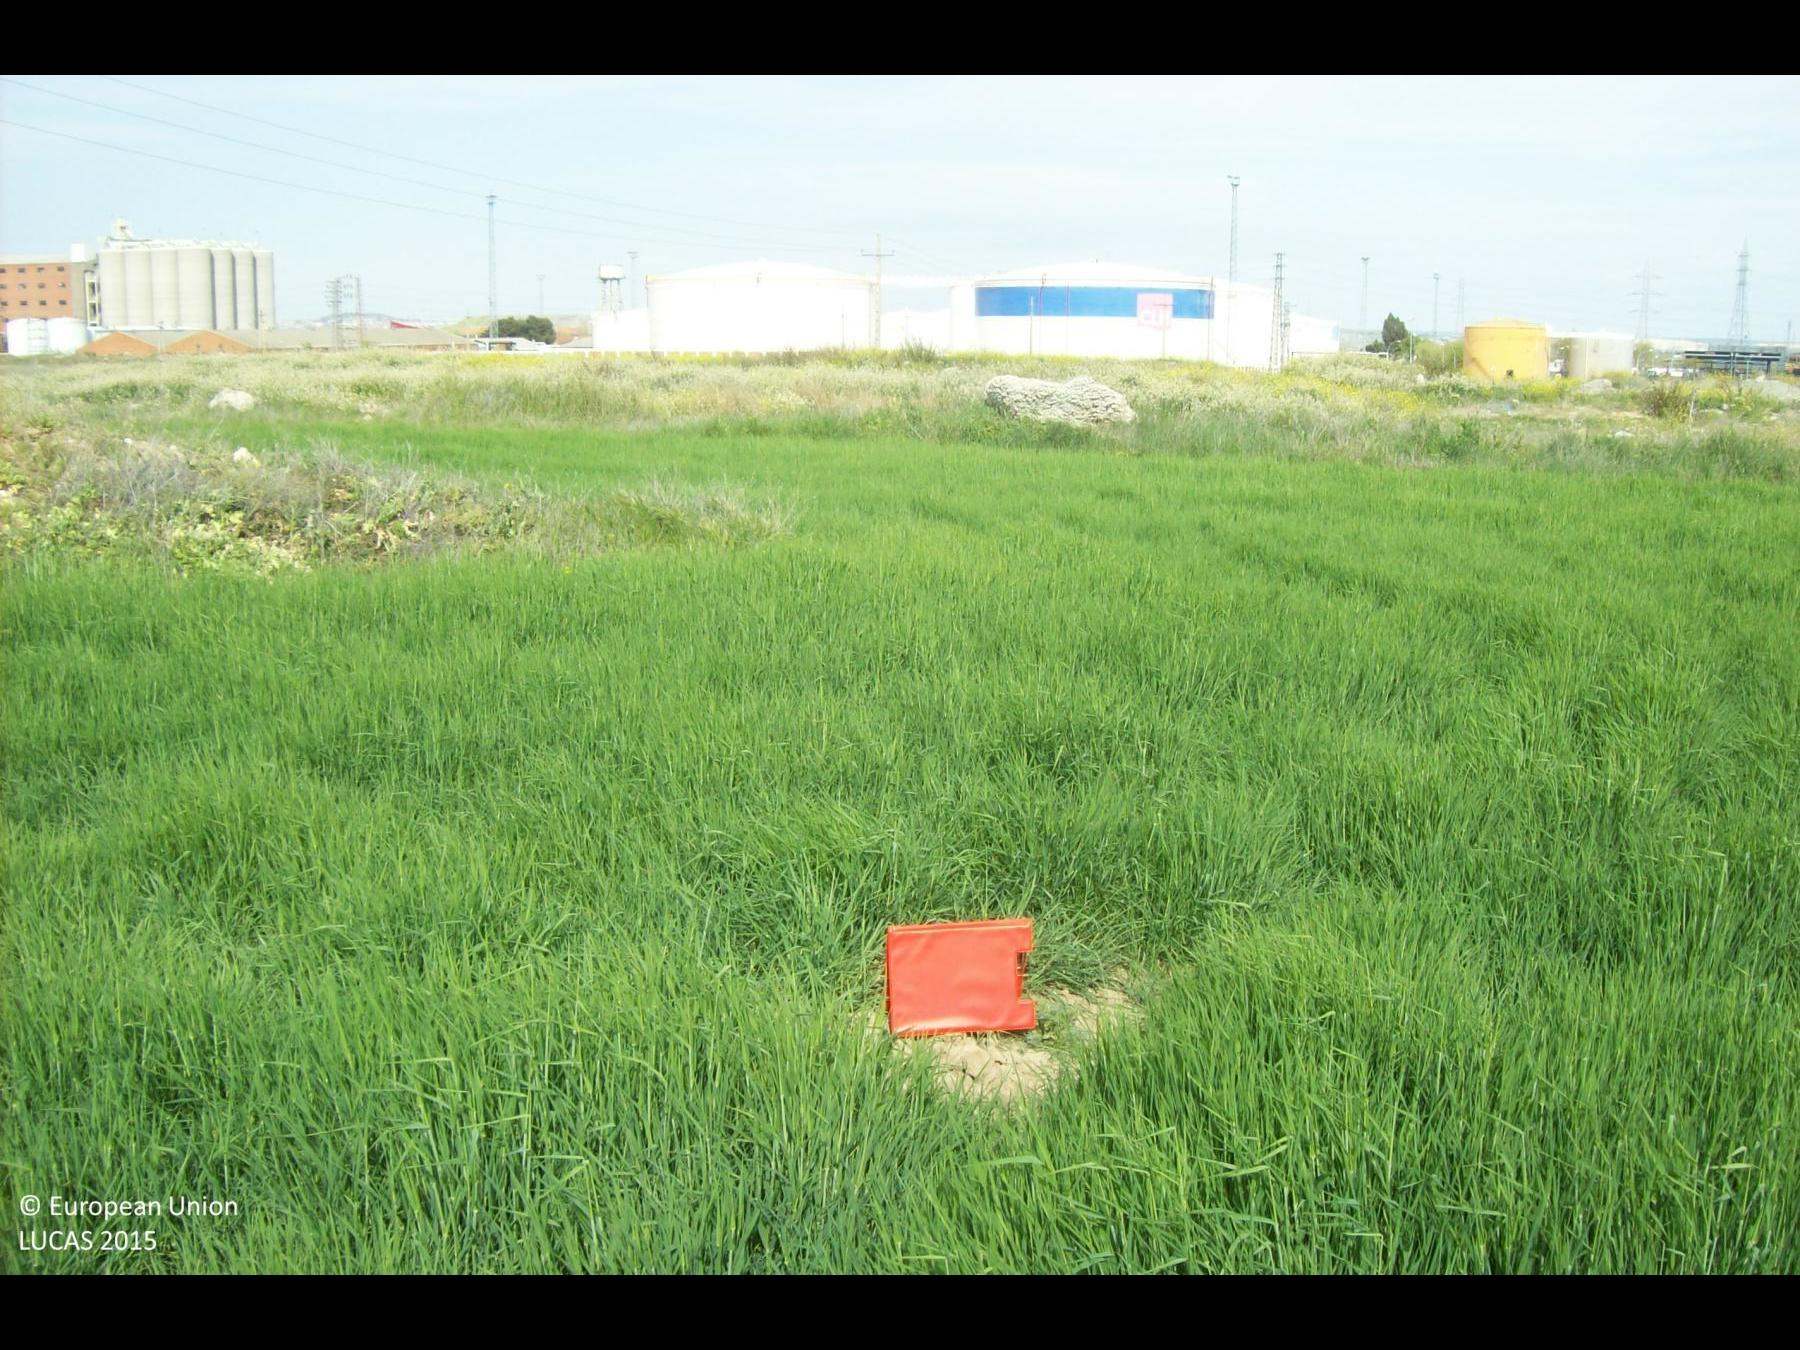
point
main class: Cropland
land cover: Barley
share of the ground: > 75 %
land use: Agriculture (excluding fallow land and kitchen gardens)
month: April
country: ES
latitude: 40.3270
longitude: -3.7008
